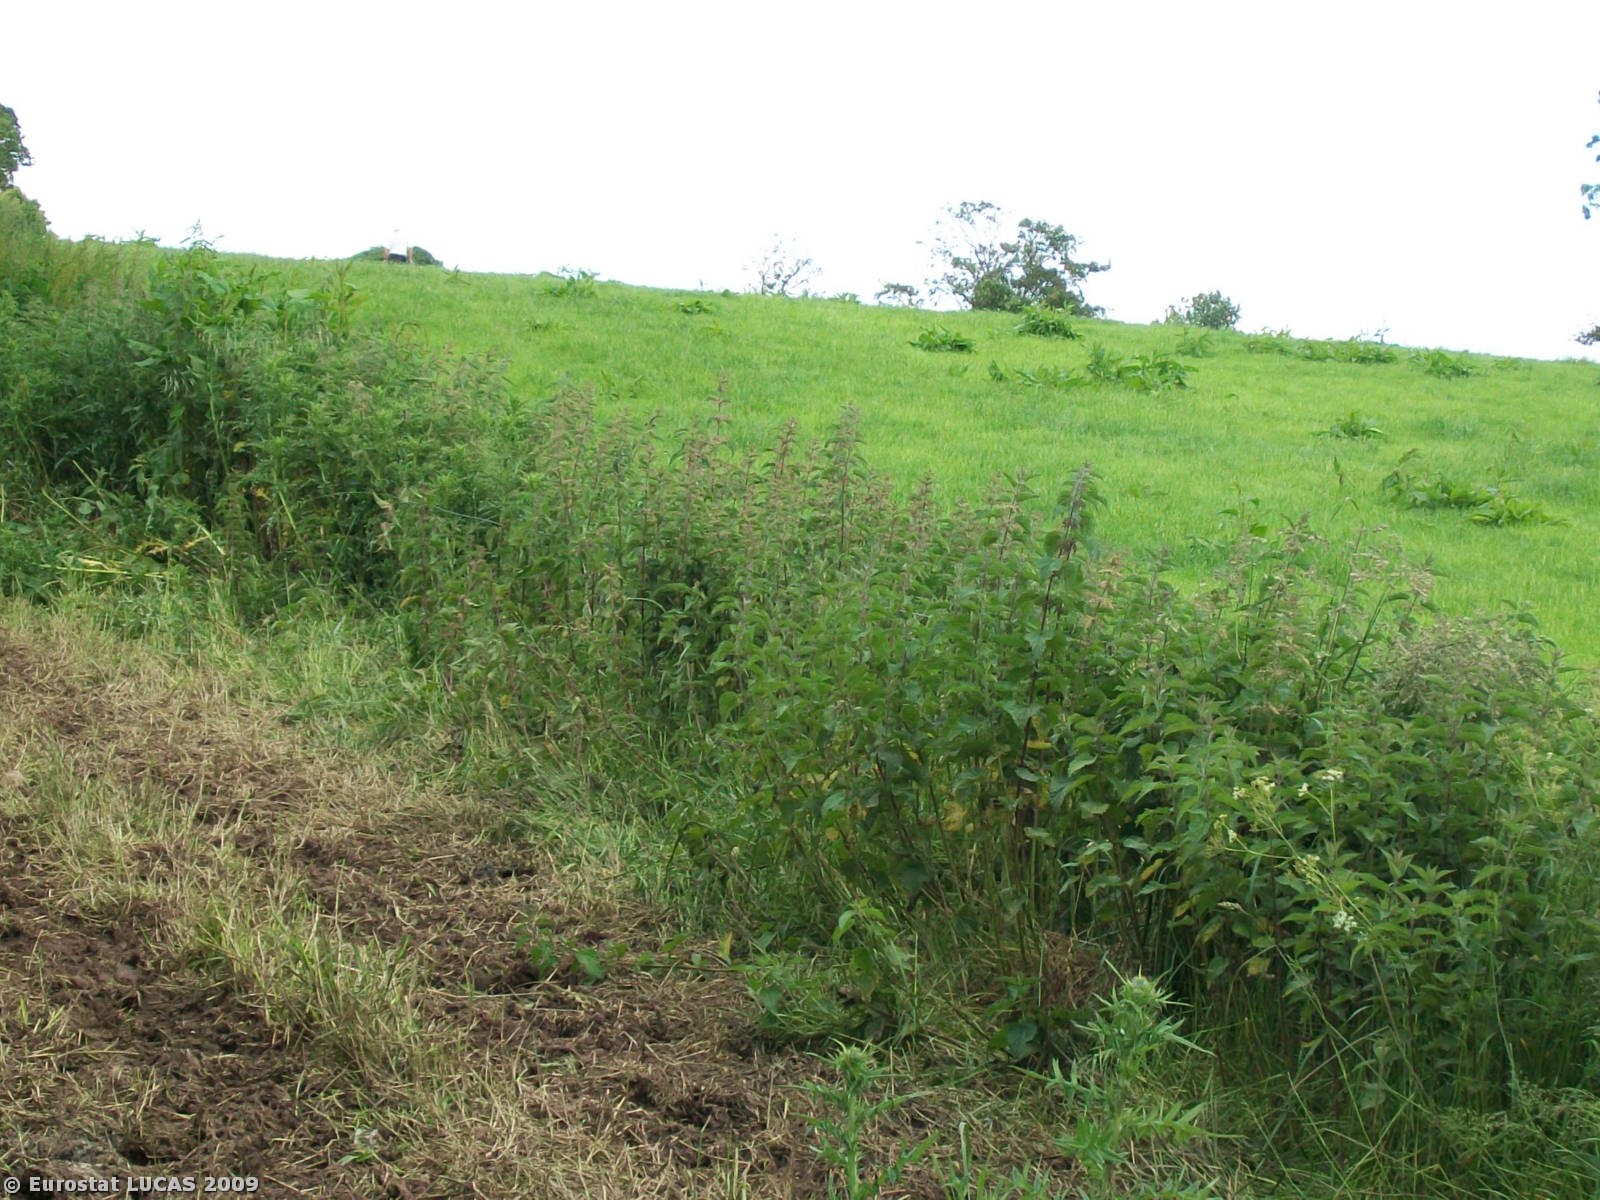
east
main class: Grassland
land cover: Grassland without tree/shrub cover
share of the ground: > 75 %
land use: Agriculture (excluding fallow land and kitchen gardens)
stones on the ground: < 10 %
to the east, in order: Grassland without tree/shrub cover; Fences; Managed hedges; Tracks; Grass margins; Fences; Grassland without tree/shrub cover
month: June
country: GB
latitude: 52.9395
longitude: -2.6116
